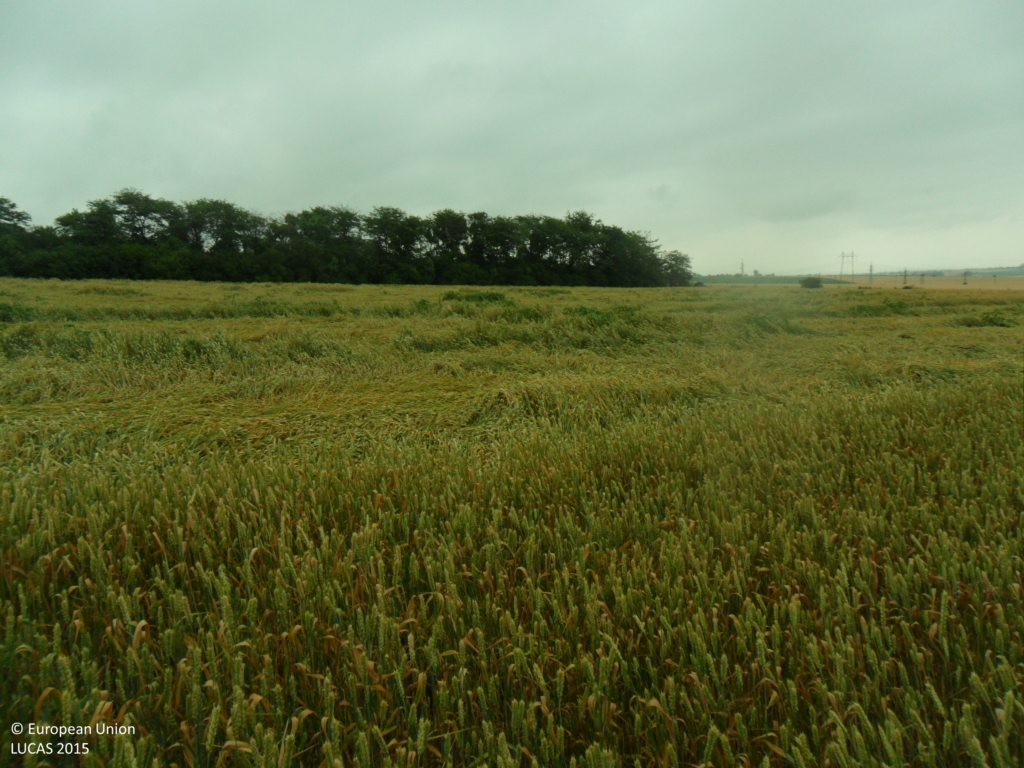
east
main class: Cropland
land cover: Common wheat
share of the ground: > 75 %
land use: Agriculture (excluding fallow land and kitchen gardens)
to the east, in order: Common wheat; Broadleaved woodland; Common wheat
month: June
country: BG
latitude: 43.3222
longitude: 26.9968
